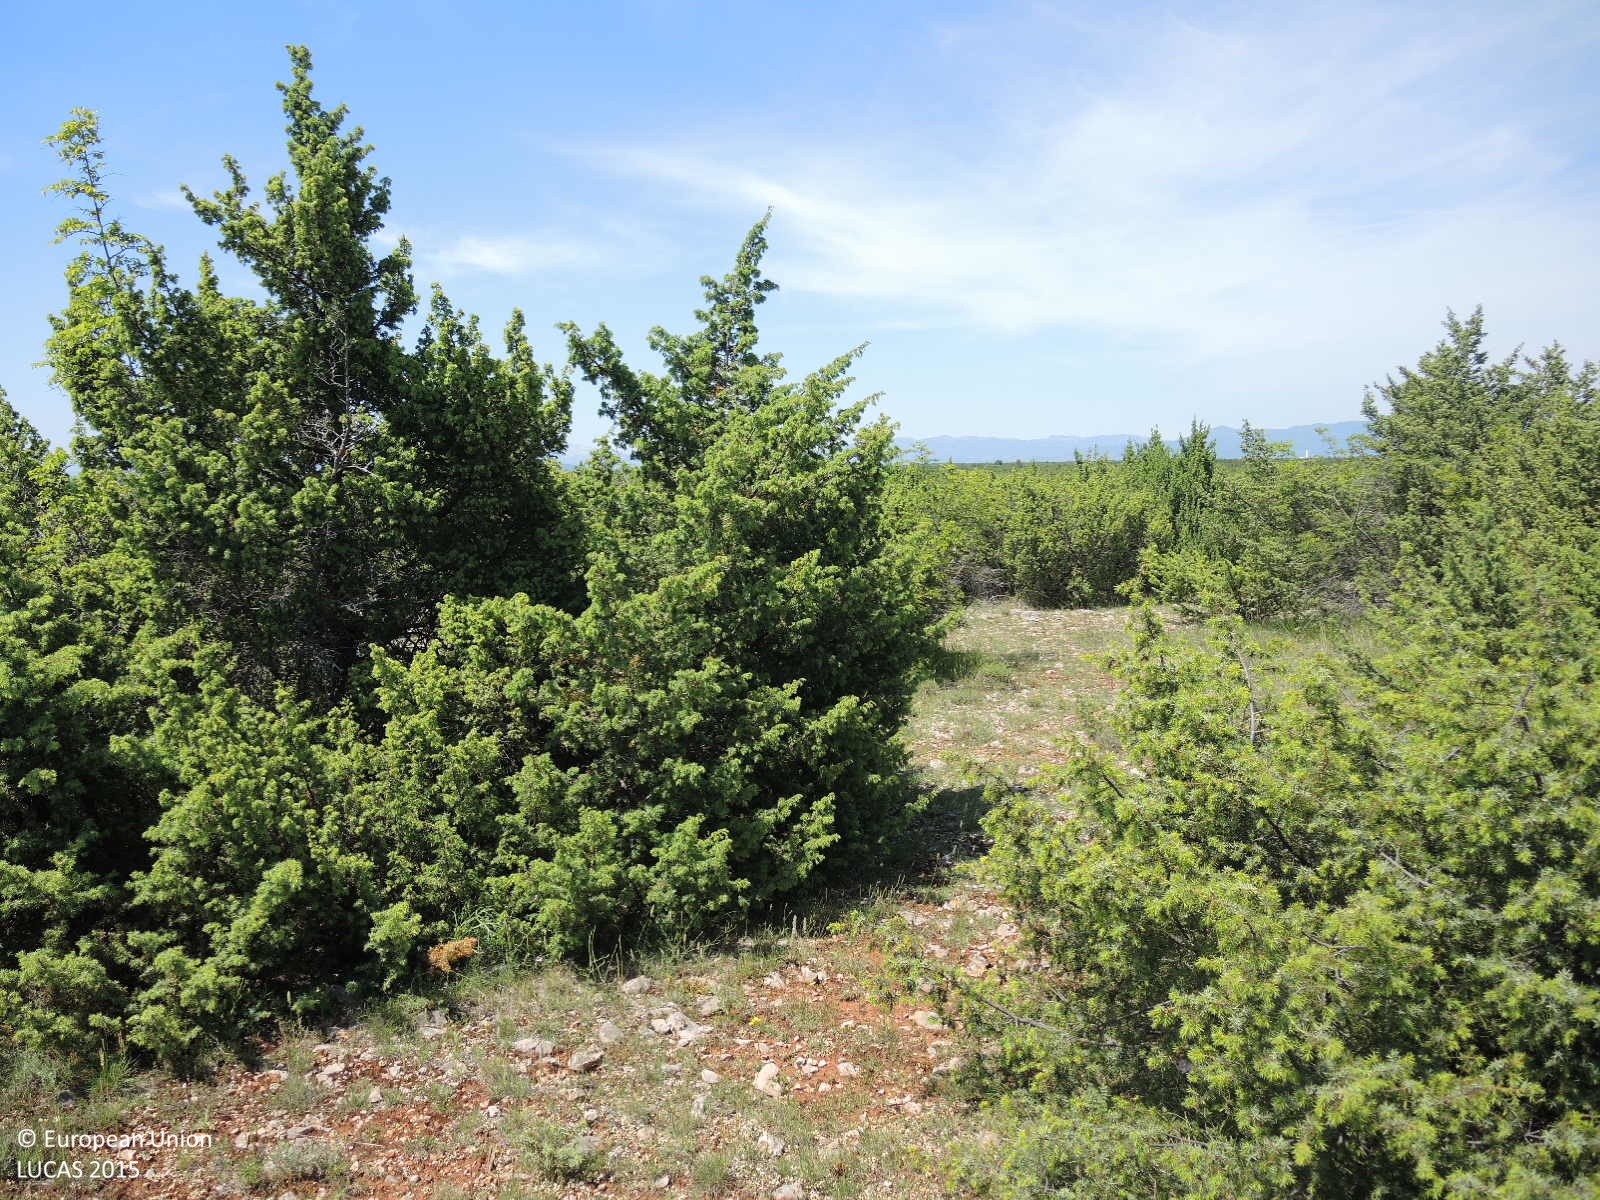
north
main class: Shrubland
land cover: Shrubland with sparse tree cover
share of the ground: 25 - 50 %
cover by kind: shrubs 45 %, herbaceous plants 45 %, coniferous forest trees 5 %, consolidated bare surface 5 %
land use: Semi-natural and natural areas not in use
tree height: < 5 m
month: May
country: HR
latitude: 43.9276
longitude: 15.9332
